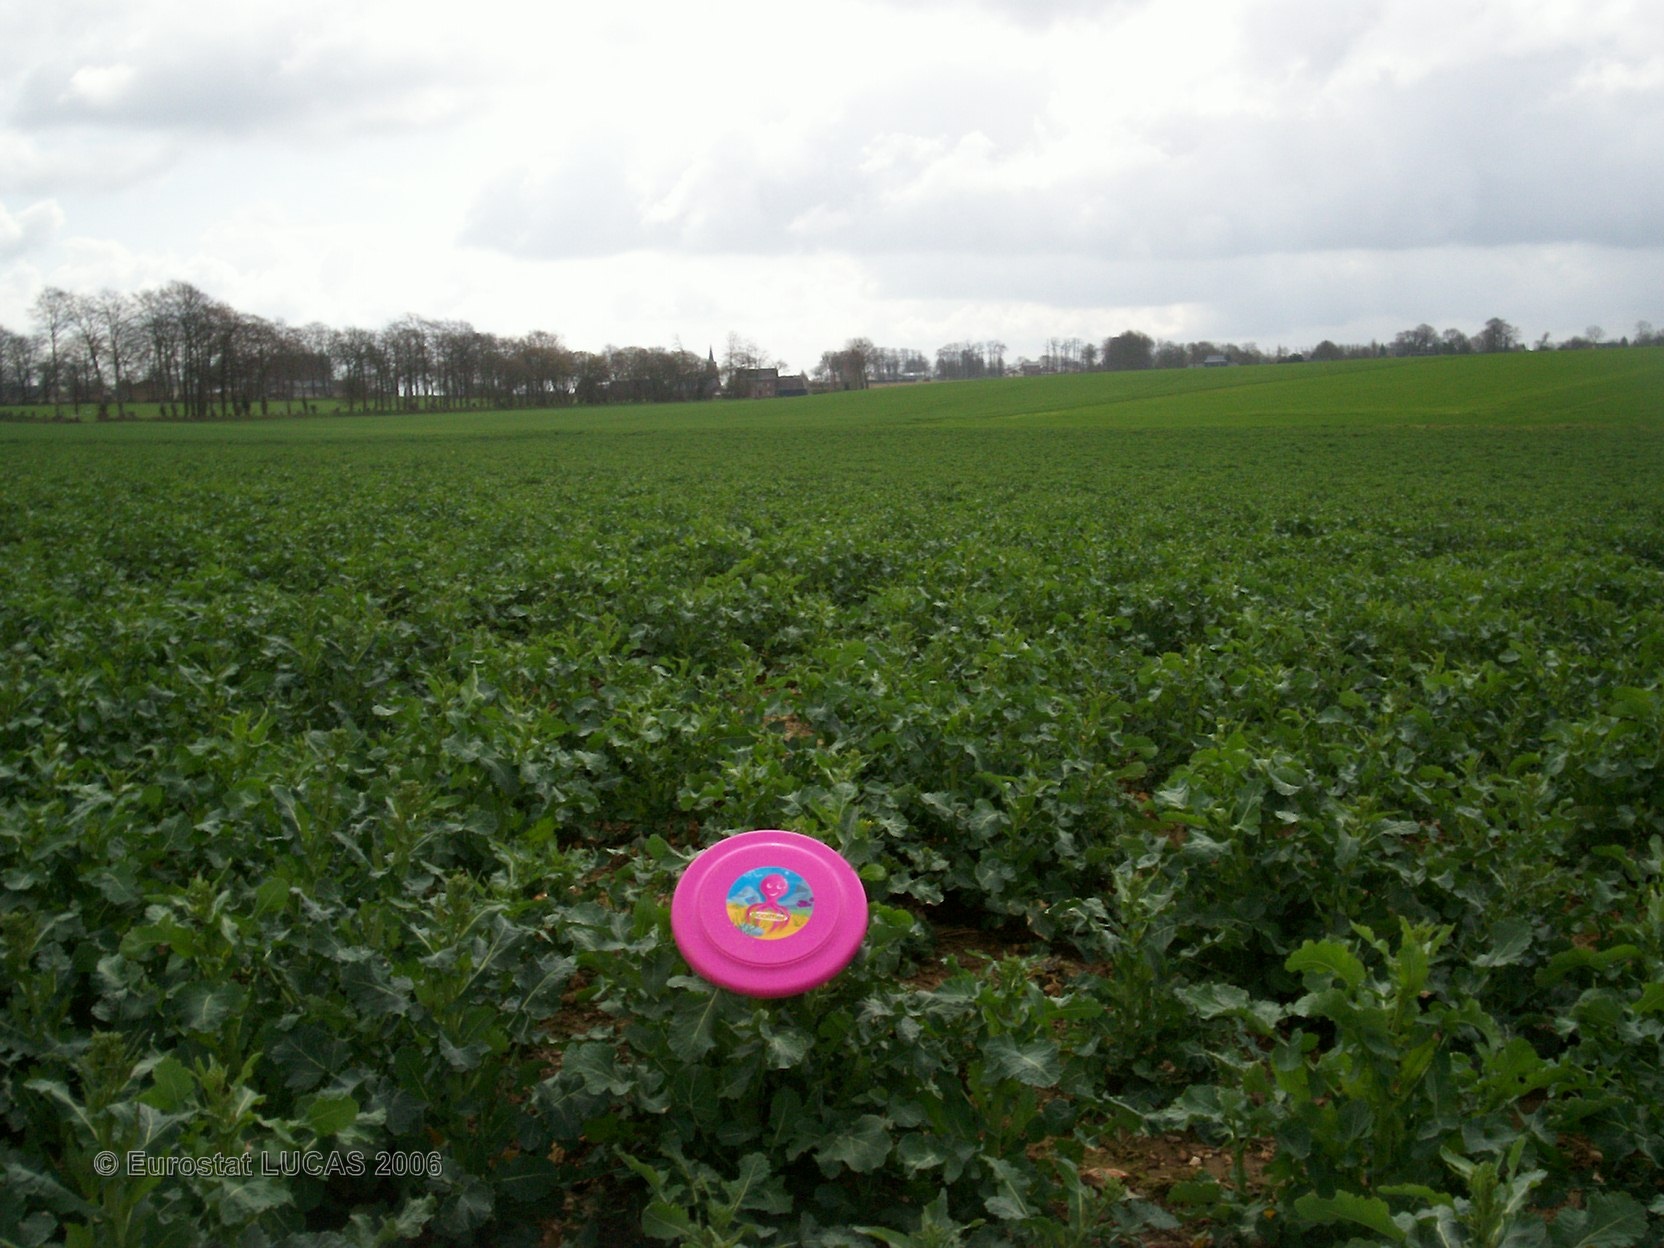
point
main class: Cropland
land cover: Rape and turnip rape
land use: Agriculture (excluding fallow land and kitchen gardens)
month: April
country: FR
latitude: 49.7284
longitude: 0.8898
